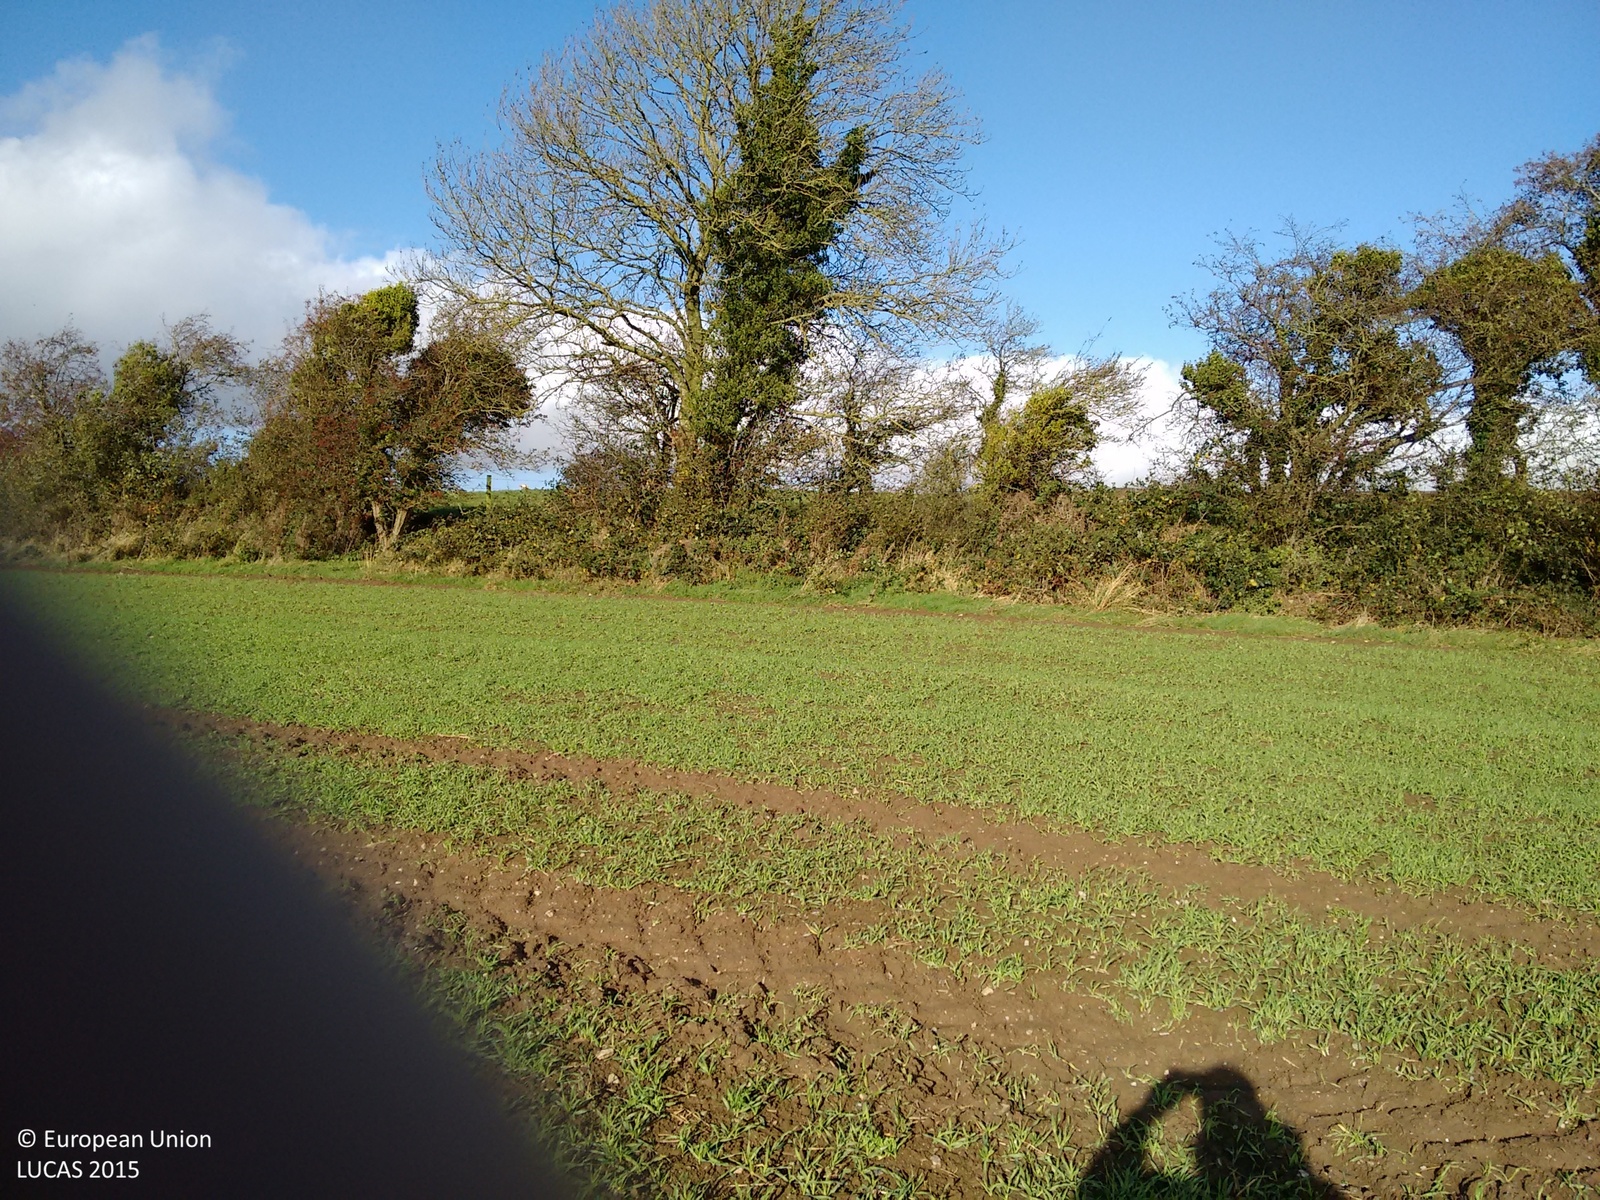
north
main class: Cropland
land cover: Barley
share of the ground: < 10 %
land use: Agriculture (excluding fallow land and kitchen gardens)
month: November
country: IE
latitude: 54.8693
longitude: -7.5621
